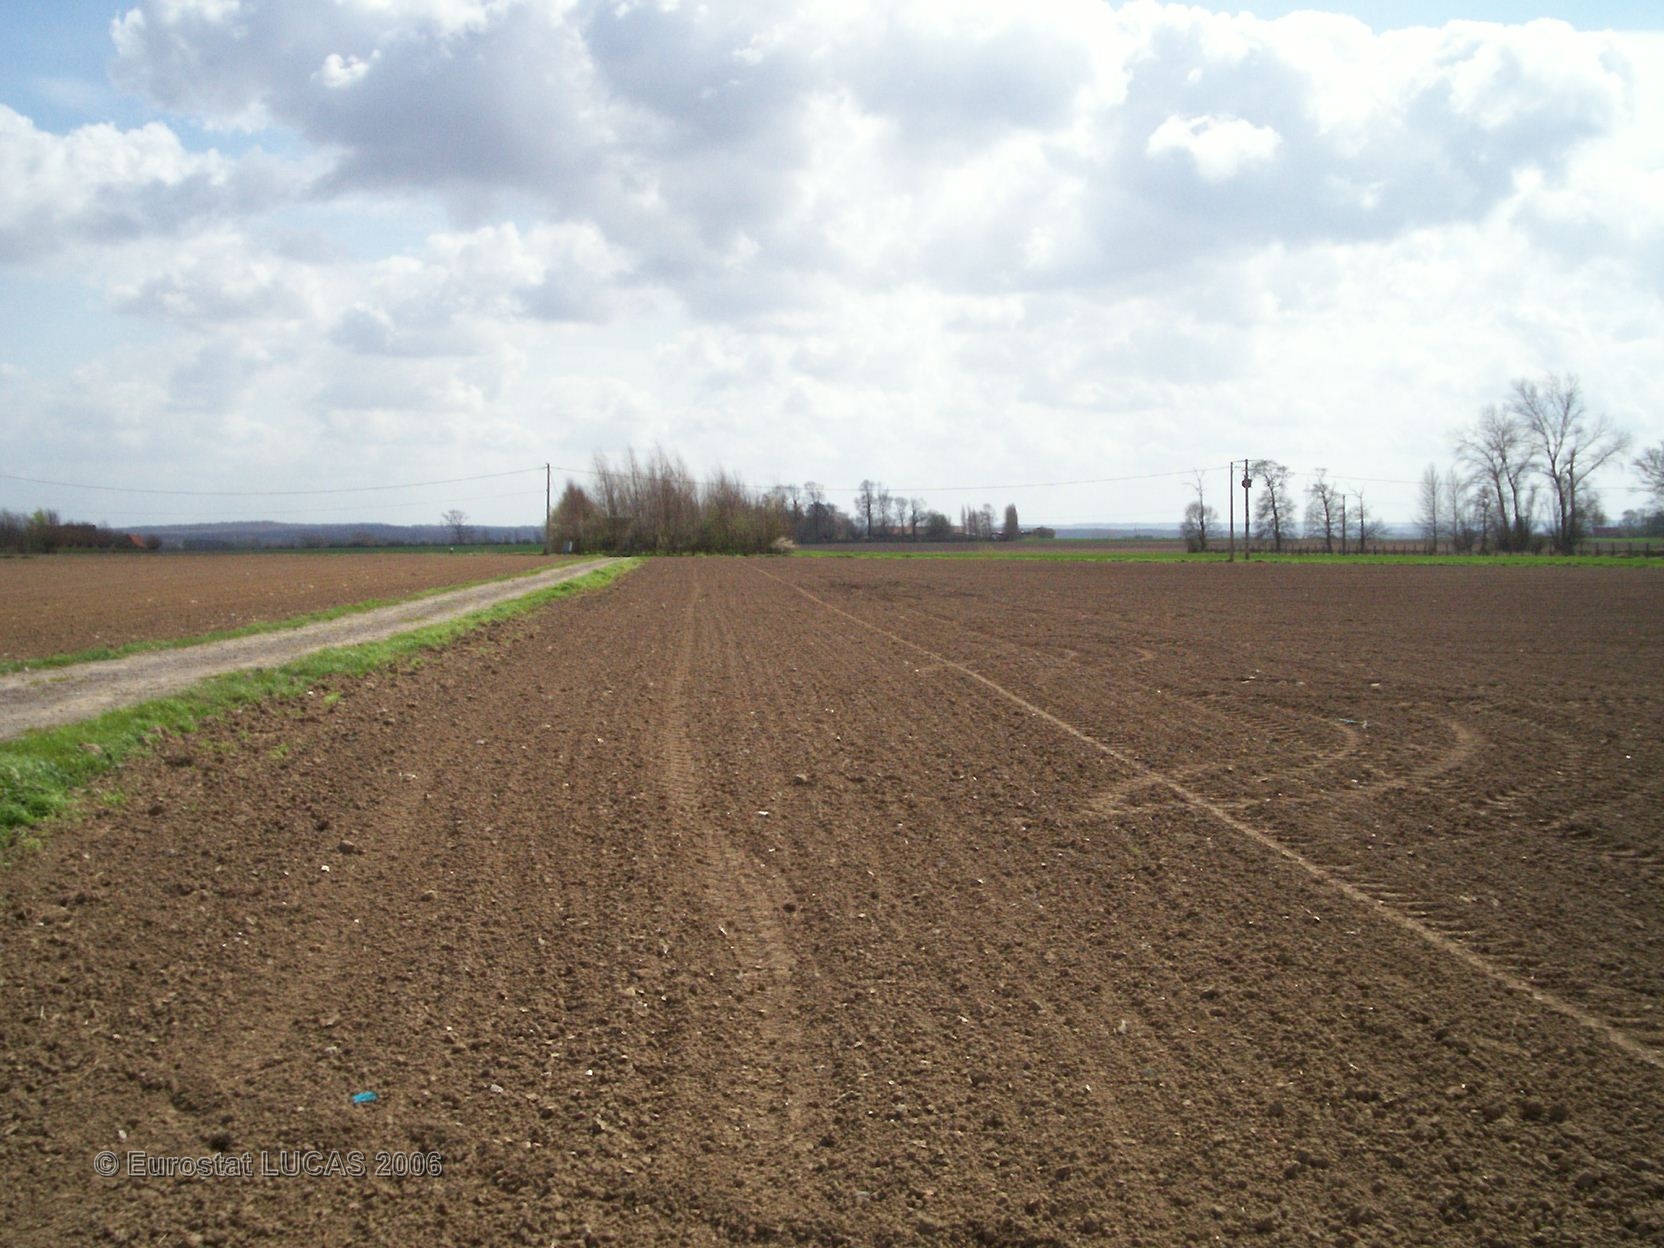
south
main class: Cropland
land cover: Sugar beet
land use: Agriculture (excluding fallow land and kitchen gardens)
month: May
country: FR
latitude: 50.8093
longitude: 2.3085
